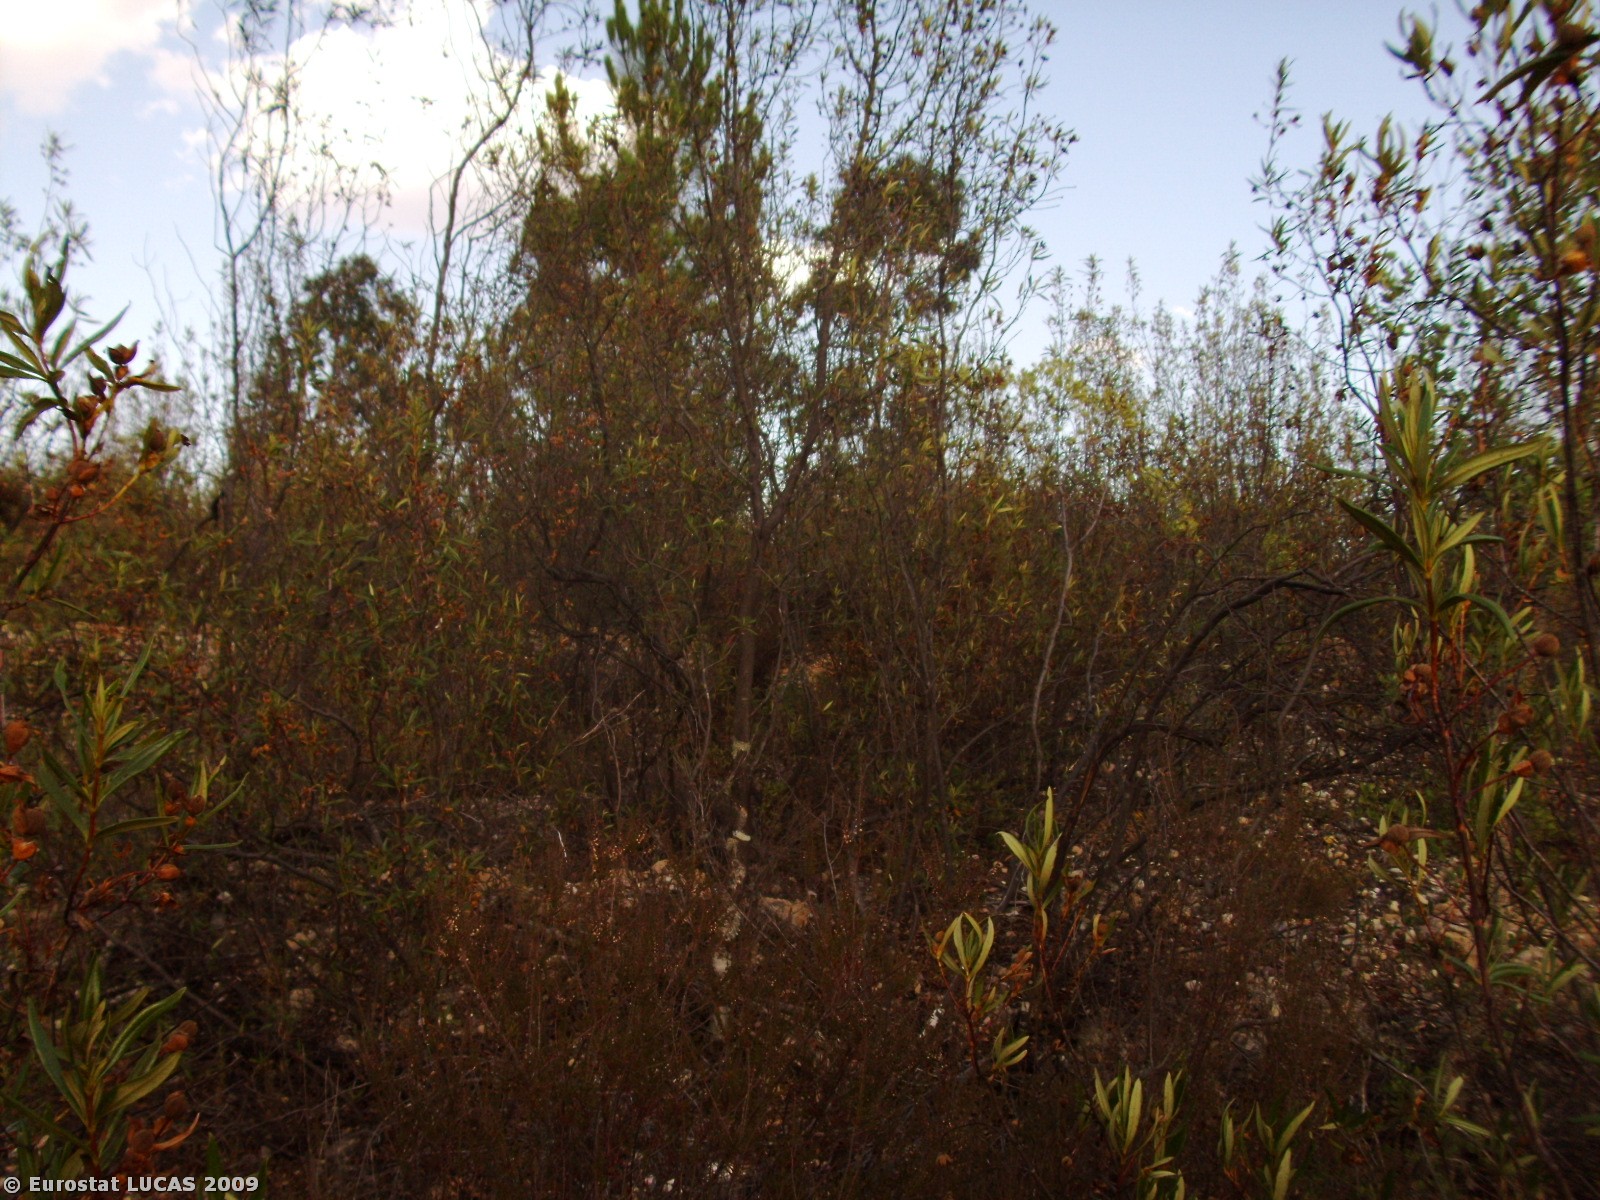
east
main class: Woodland
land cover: Broadleaved woodland
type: broadleaved evergreen forest
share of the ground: 25 - 50 %
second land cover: Shrubland with sparse tree cover
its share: 25 - 50 %
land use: Forestry
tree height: > 5 m
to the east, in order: Broadleaved woodland; Shrubland with sparse tree cover; Broadleaved woodland; Shrubland with sparse tree cover; Tracks; Broadleaved woodland; Rivers and streams; Bare land; Coniferous woodland; Bare land; Lines of trees; Tracks; Lines of trees; Bare land; Mixed woodland
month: August
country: PT
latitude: 39.1904
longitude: -8.0347
